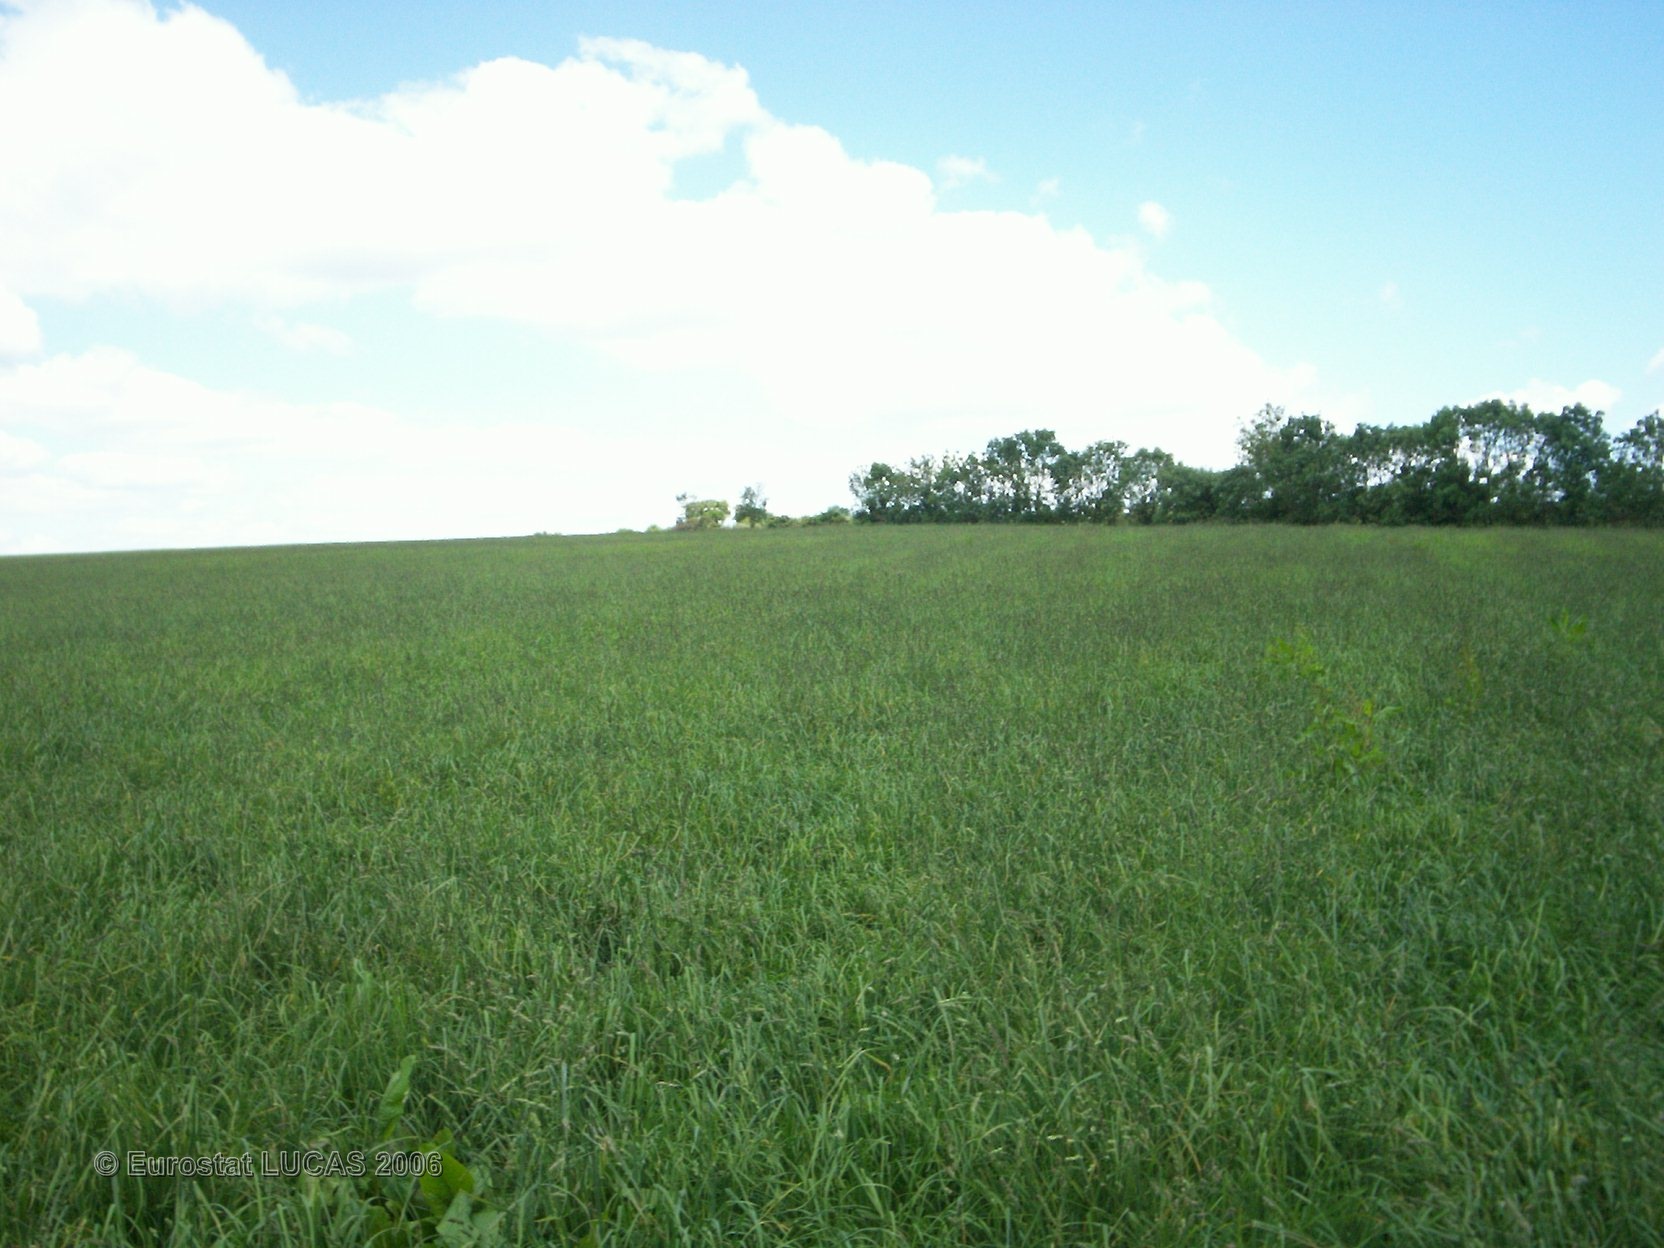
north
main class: Grassland
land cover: Grassland without tree/shrub cover
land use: Agriculture (excluding fallow land and kitchen gardens)
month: May
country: FR
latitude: 47.4421
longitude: -1.1103
